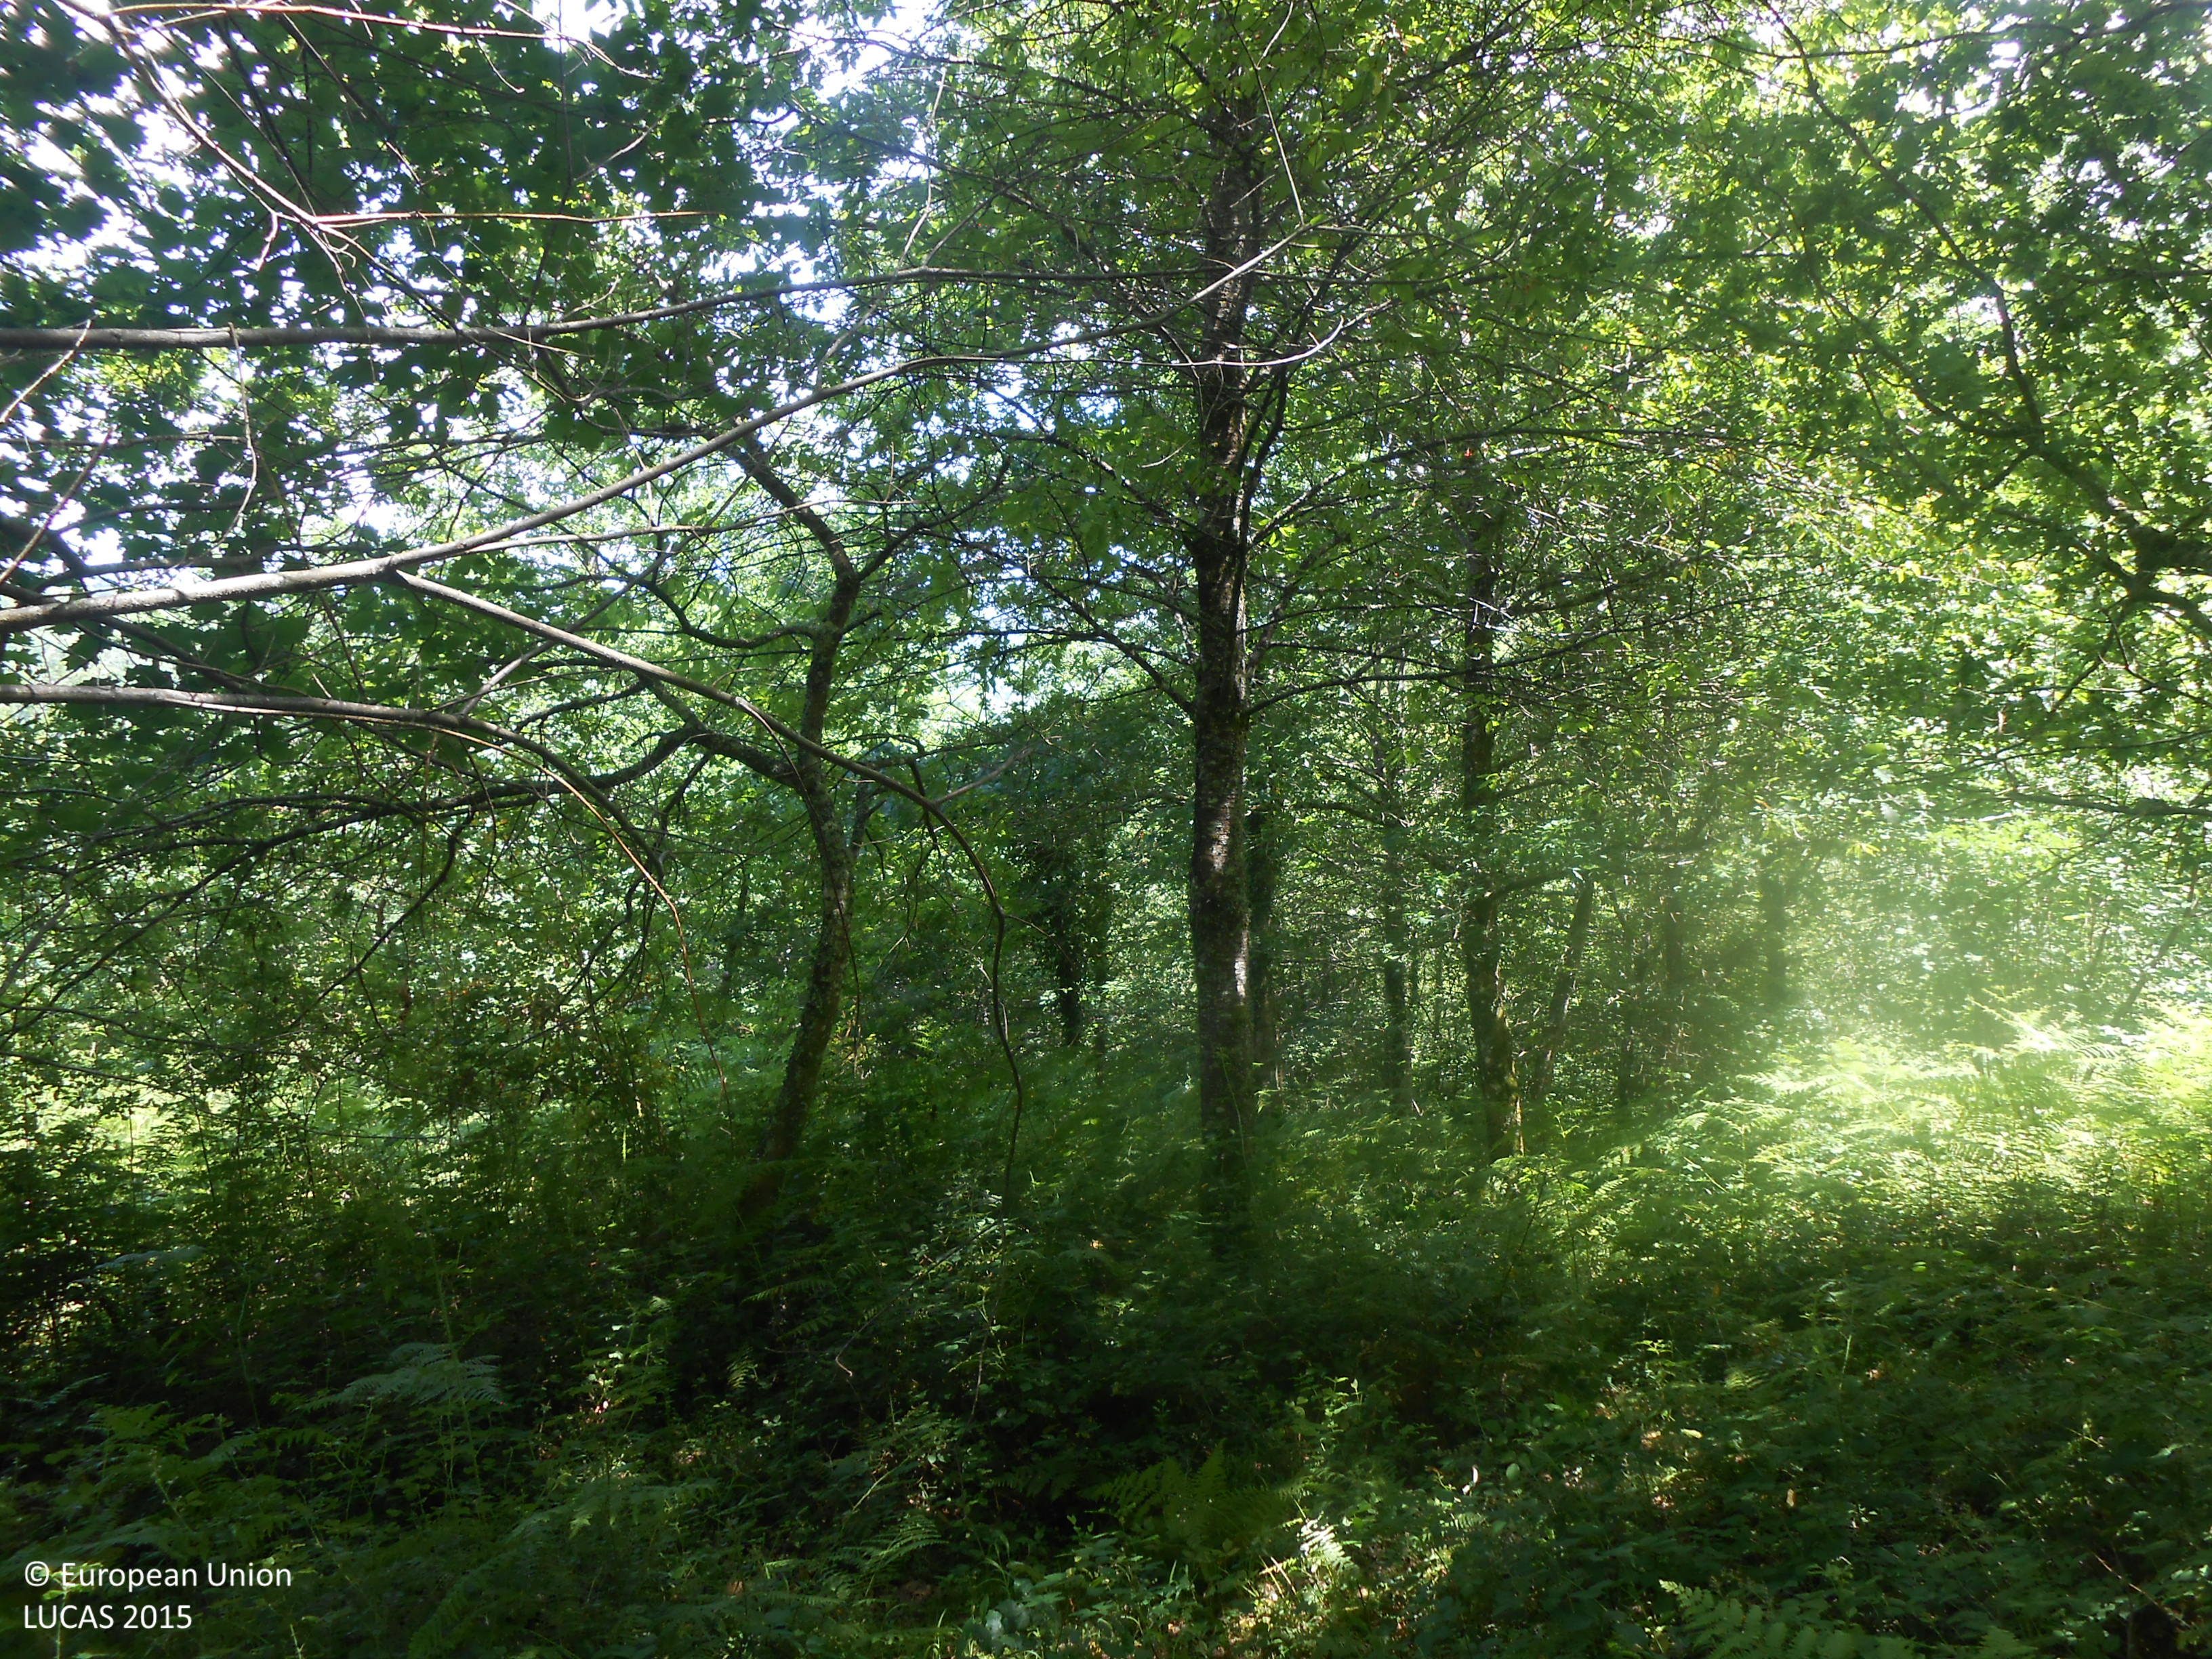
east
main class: Woodland
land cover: Broadleaved woodland
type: acidophilous oak and oak-birch forest
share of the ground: > 75 %
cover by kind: broadleaved forest trees 95 %, herbaceous plants 5 %
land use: Forestry
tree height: > 5 m
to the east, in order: Broadleaved woodland; Grass margins; Paved roads, cycling and walking lanes; Grass margins; Fences; Broadleaved woodland
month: June
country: ES
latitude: 43.1910
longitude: -1.5713
